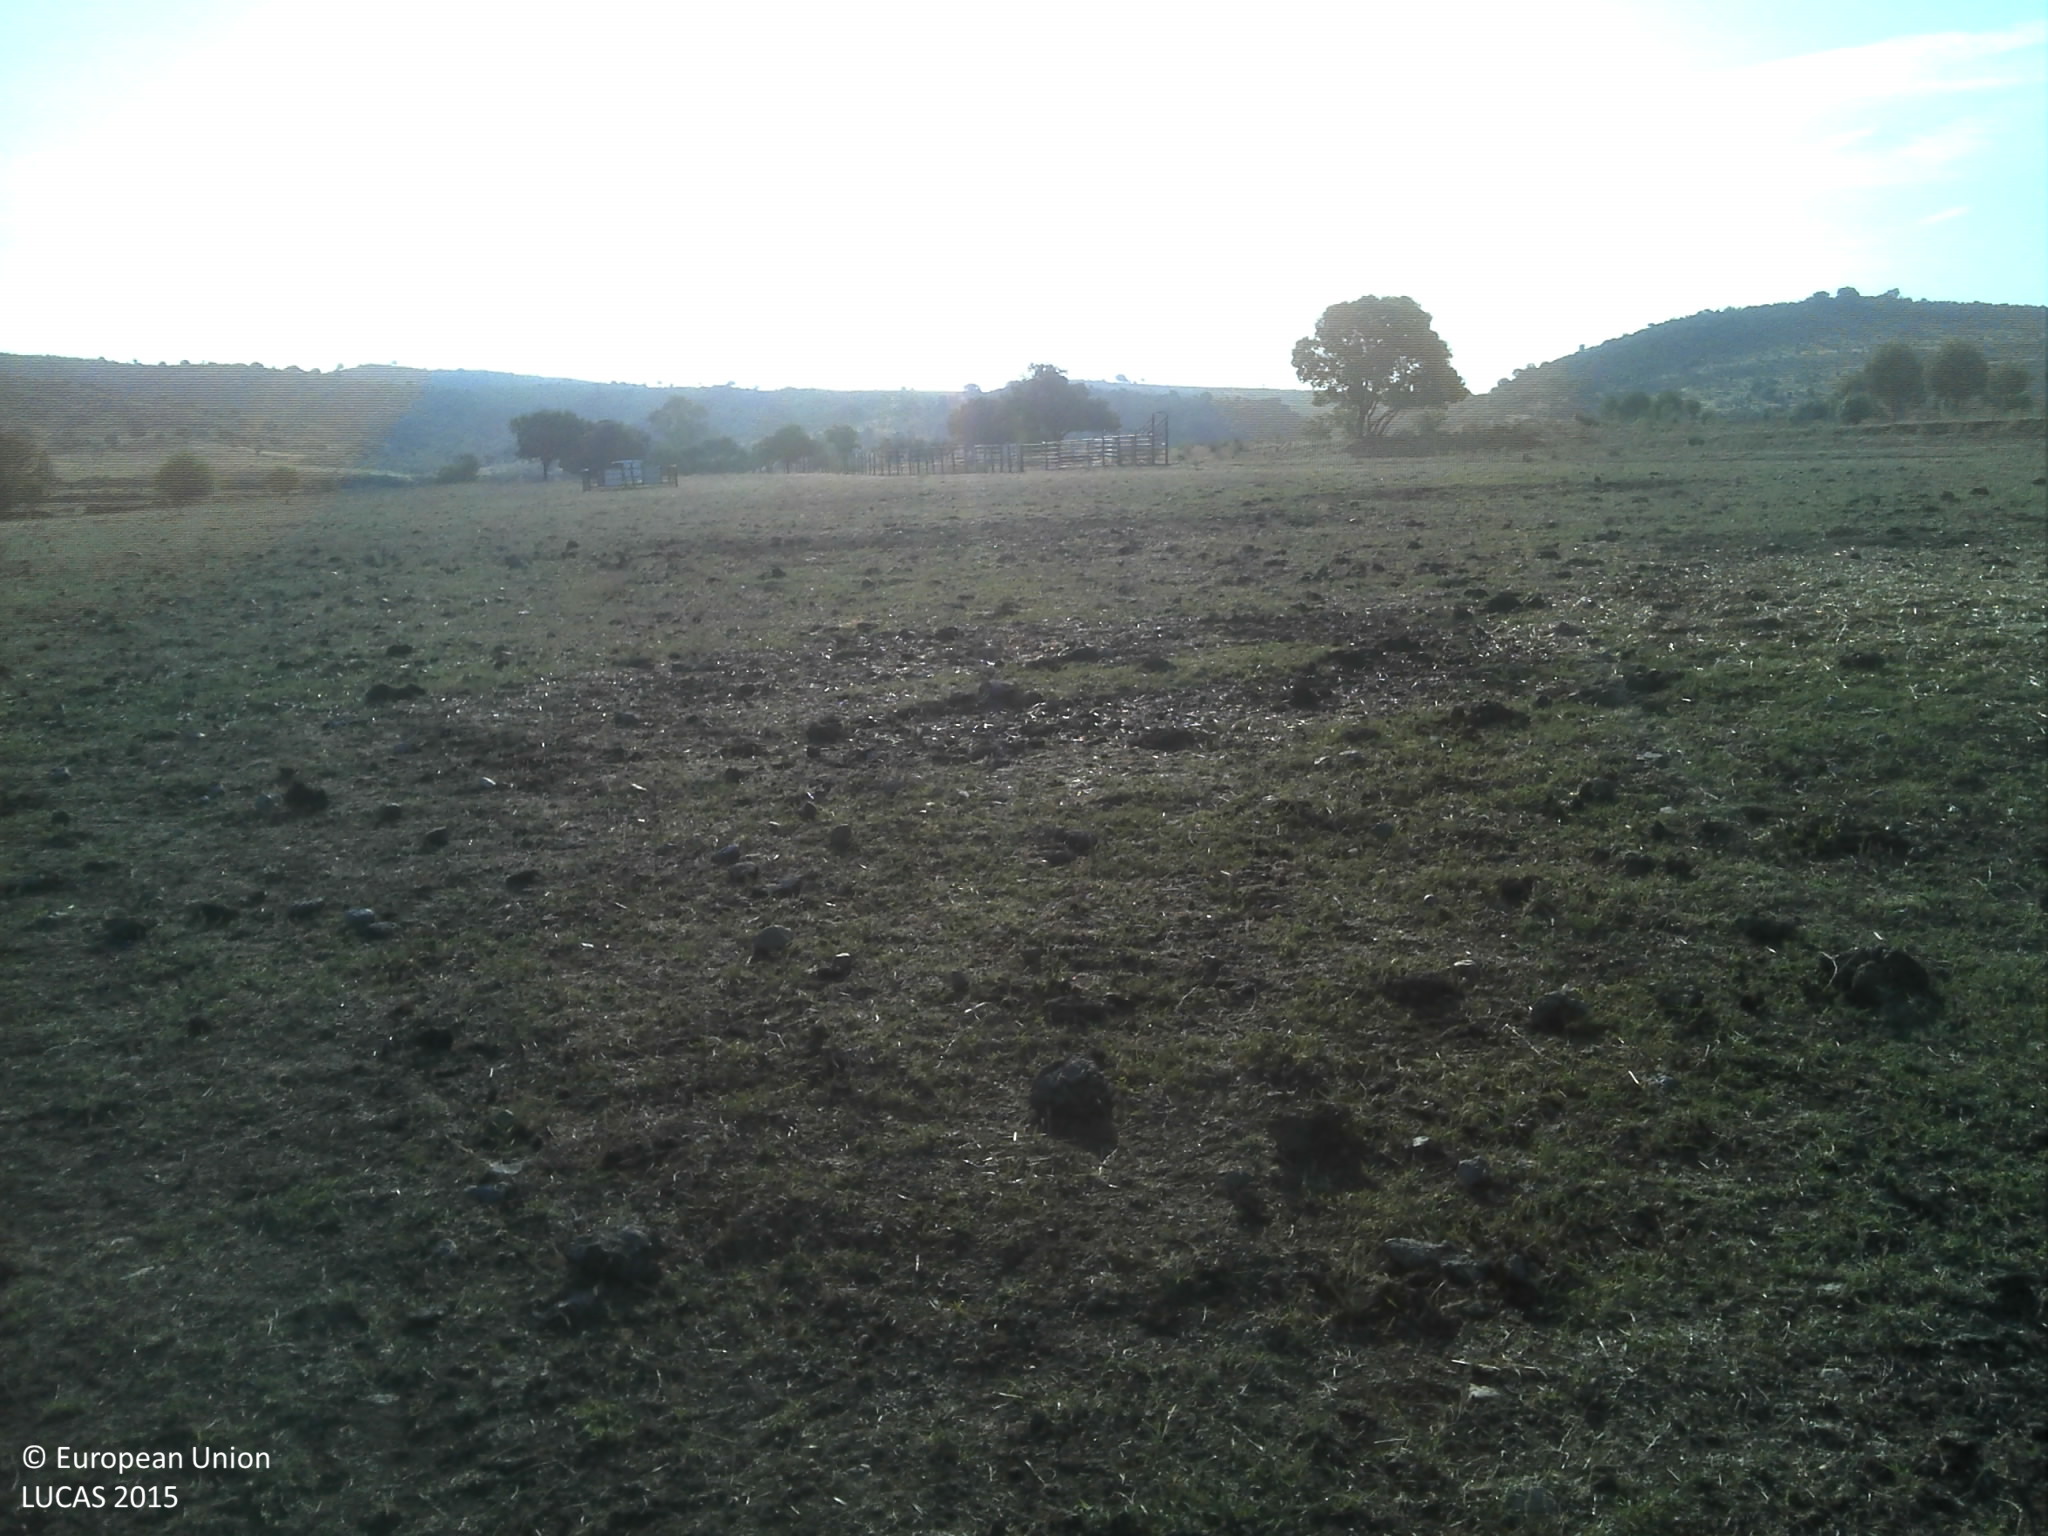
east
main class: Grassland
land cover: Grassland without tree/shrub cover
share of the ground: 10 - 25 %
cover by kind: unconsolidated bare surface 70 %, herbaceous plants 25 %
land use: Agriculture (excluding fallow land and kitchen gardens)
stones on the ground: 10 - 25 %
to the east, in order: Grassland without tree/shrub cover; Tracks; Grassland without tree/shrub cover; Single bushes/trees; Grassland without tree/shrub cover; Grass margins; Ditches and canals; Grass margins; Tracks; Broadleaved woodland
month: June
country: PT
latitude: 39.8969
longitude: -7.2042
